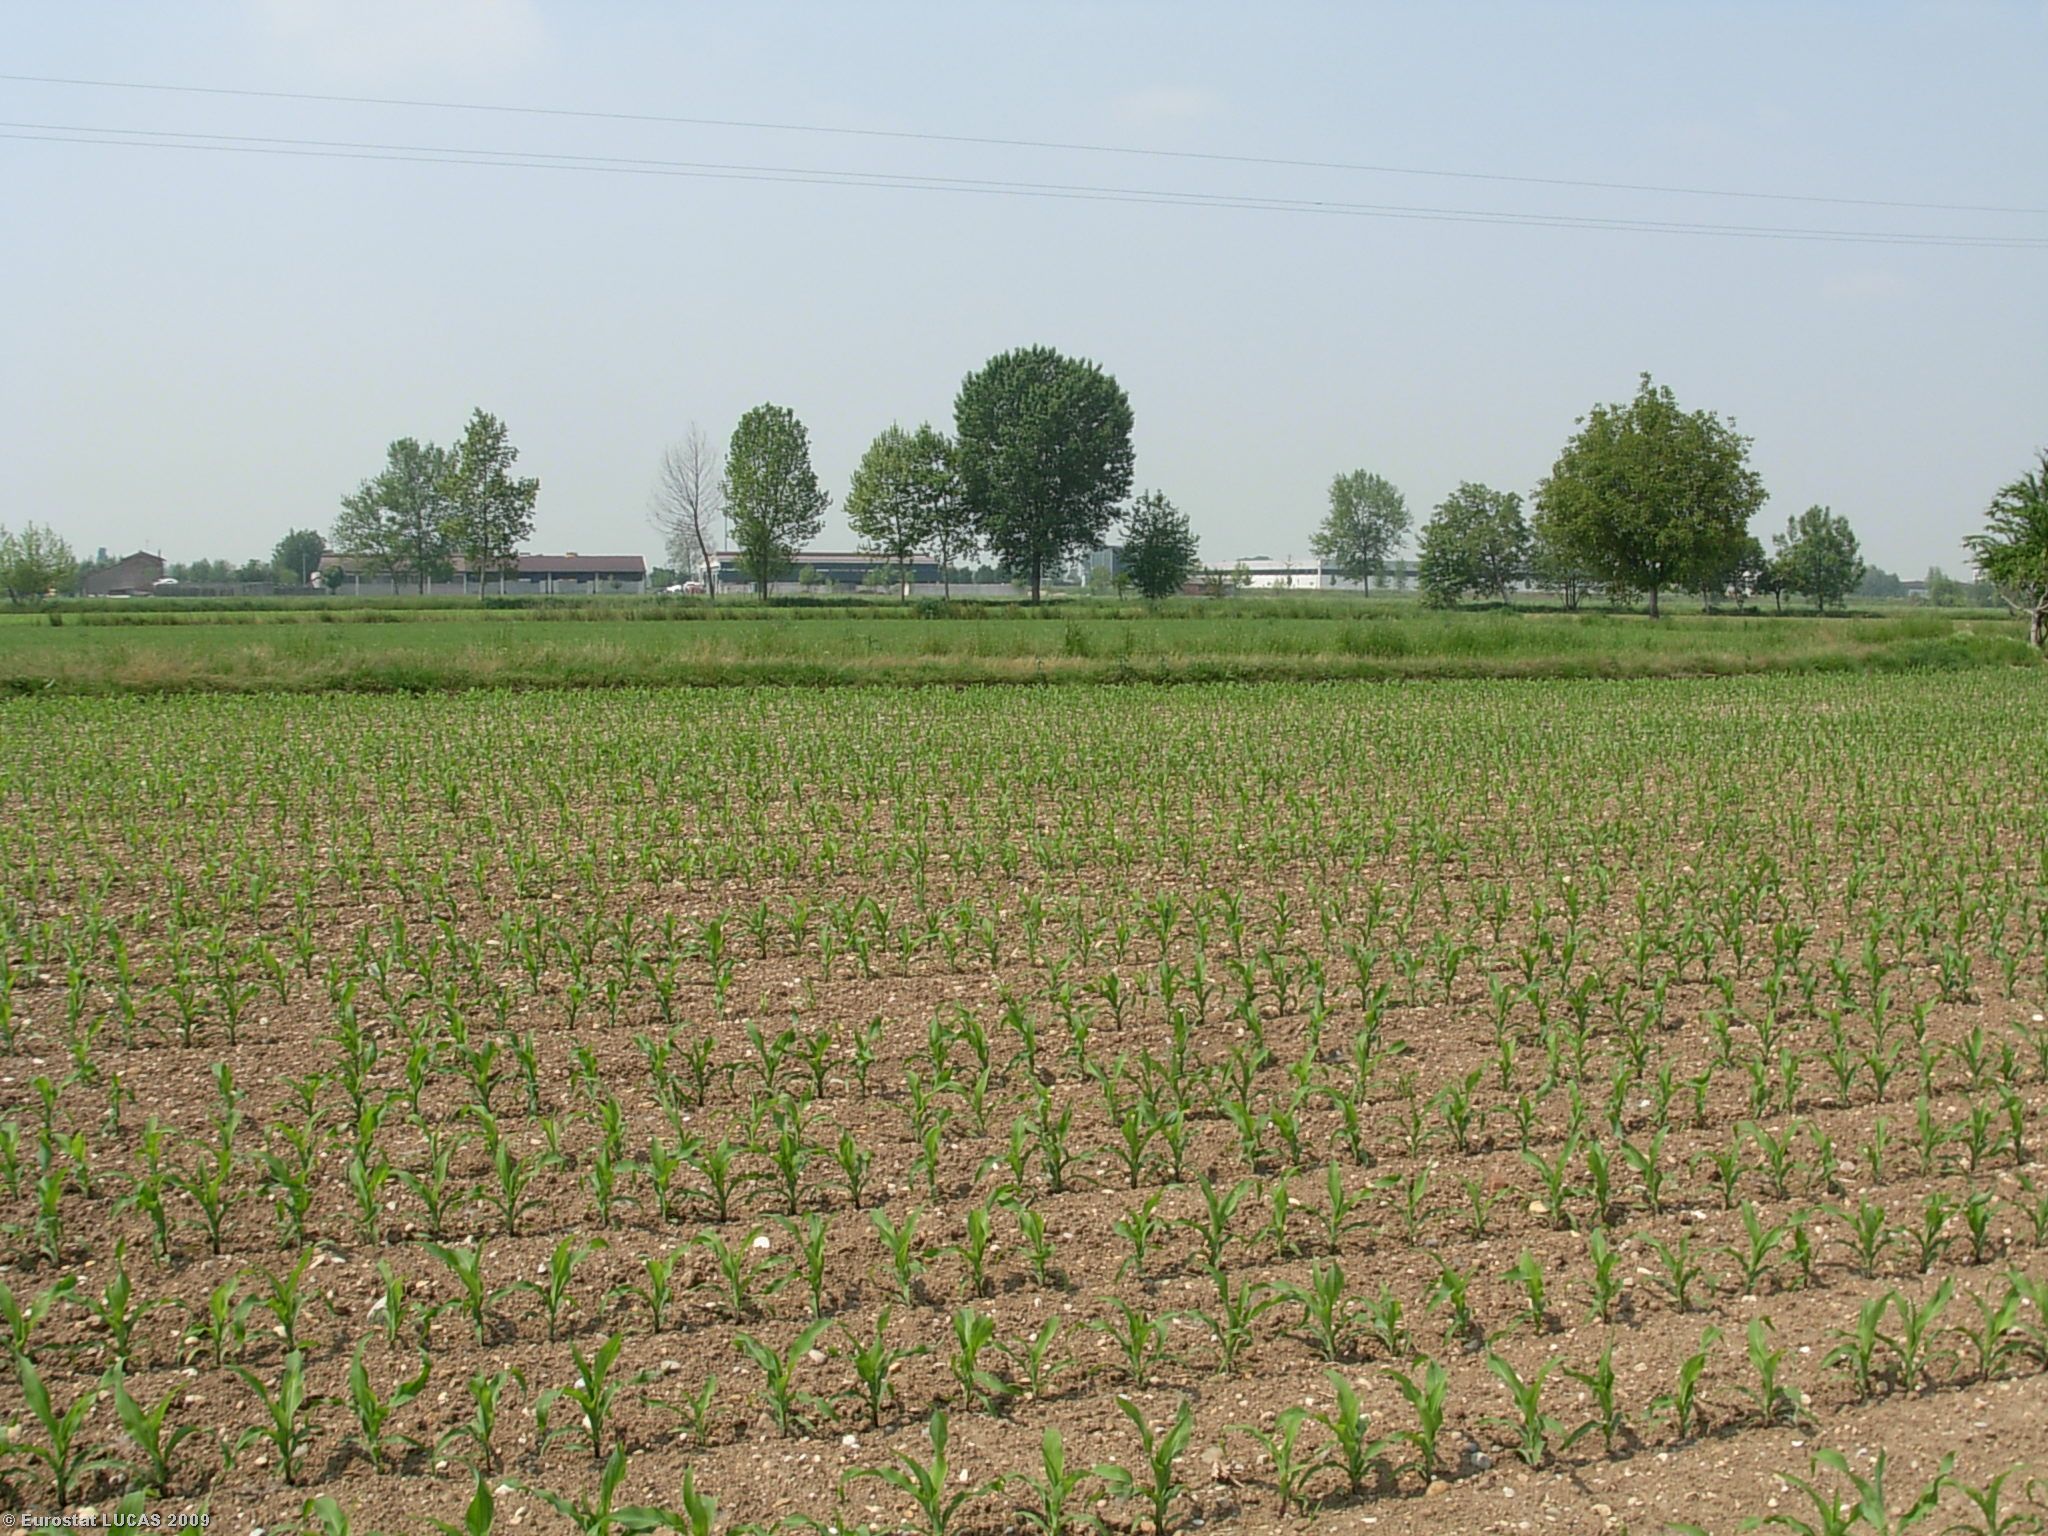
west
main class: Cropland
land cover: Maize
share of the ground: < 10 %
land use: Agriculture (excluding fallow land and kitchen gardens)
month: May
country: IT
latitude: 45.3413
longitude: 10.4459
